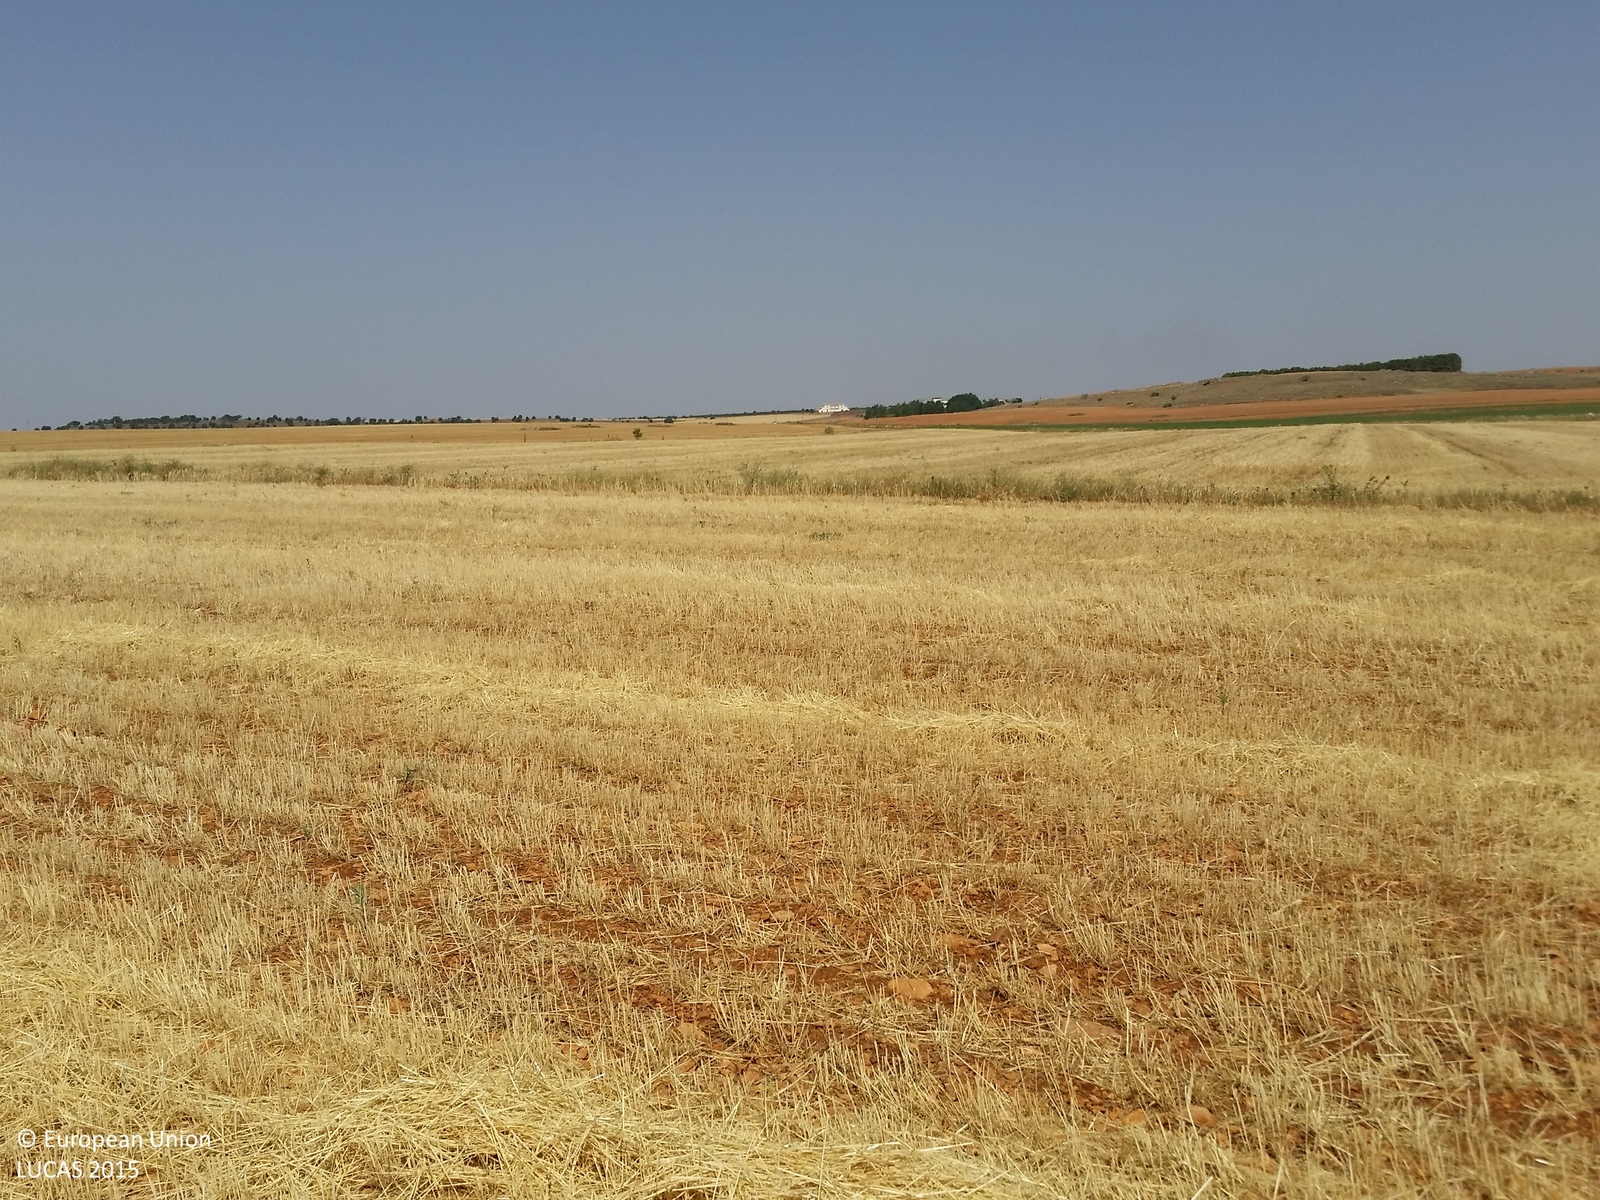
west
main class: Cropland
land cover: Barley
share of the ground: < 10 %
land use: Agriculture (excluding fallow land and kitchen gardens)
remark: Harvested field
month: June
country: ES
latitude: 38.8301
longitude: -2.5947
